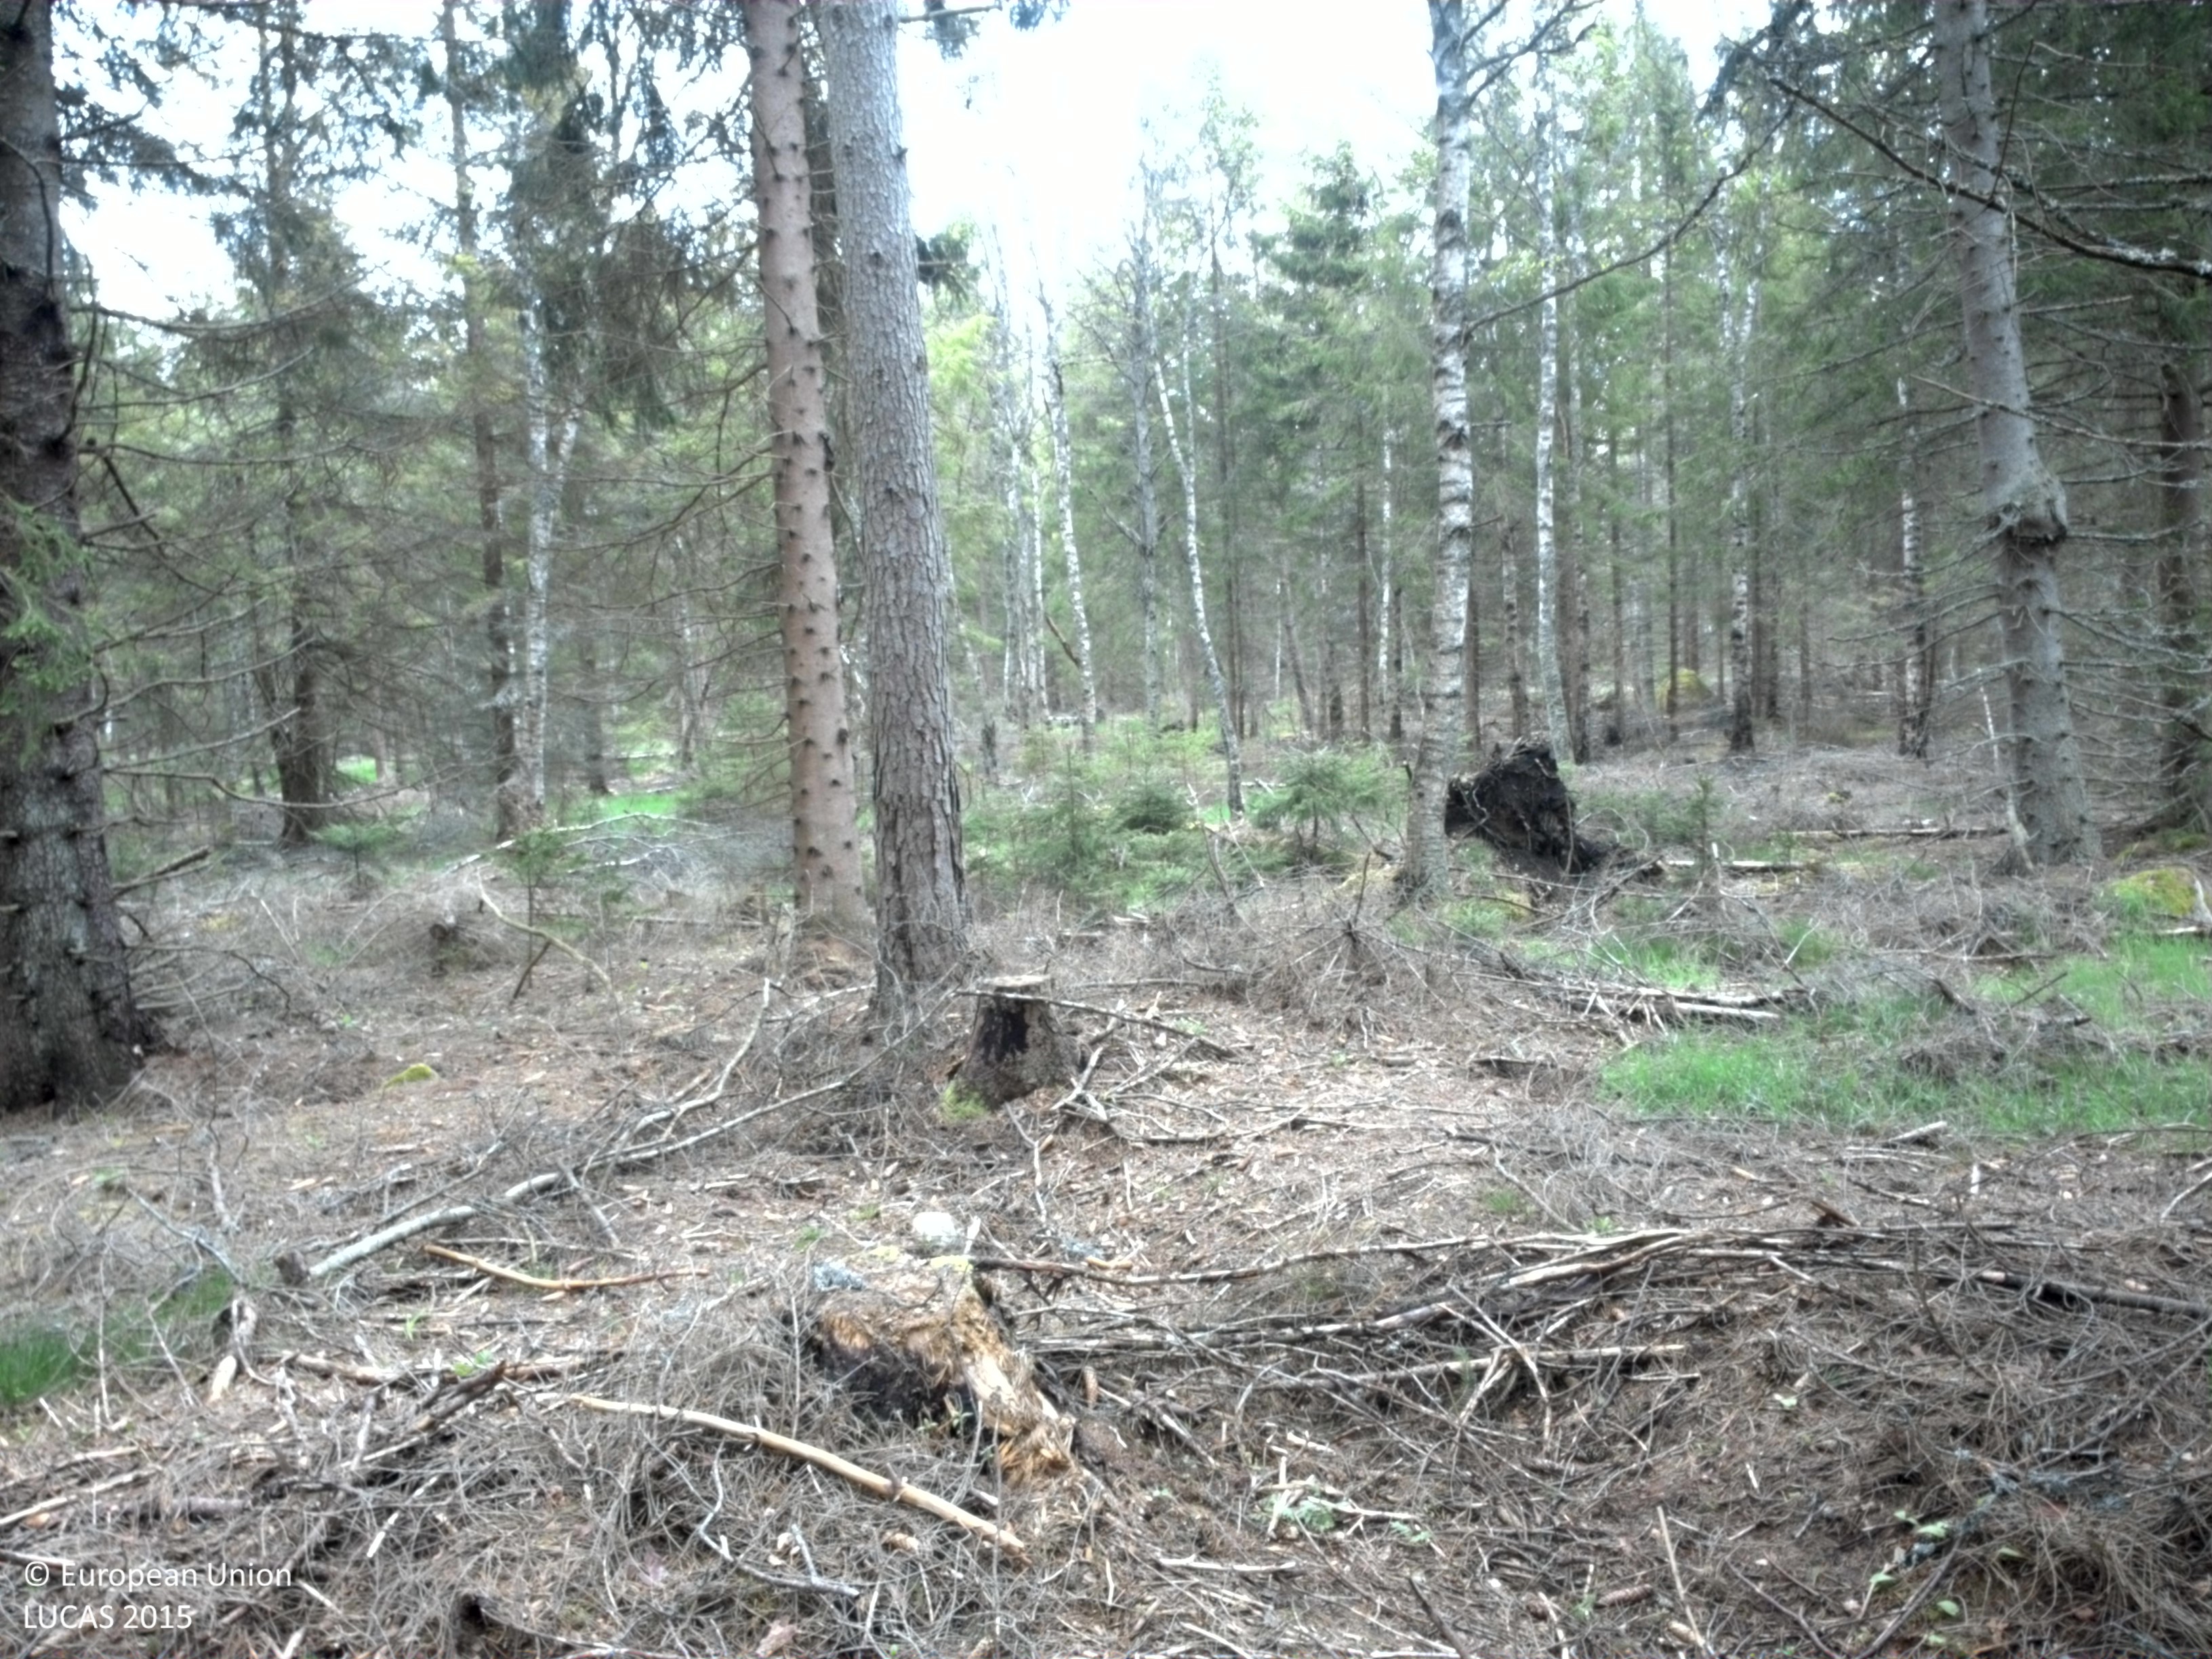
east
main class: Woodland
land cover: Spruce dominated coniferous woodland
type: boreal forest
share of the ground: 50 - 75 %
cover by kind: coniferous forest trees 50 %, herbaceous plants 15 %, broadleaved forest trees 10 %, lichens and mosses 10 %, unconsolidated bare surface 10 %, shrubs 5 %
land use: Forestry
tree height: > 5 m
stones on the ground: < 10 %
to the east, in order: Spruce dominated coniferous woodland; Ditches and canals; Spruce dominated mixed woodland; Spruce dominated coniferous woodland; Grassland with sparse tree/shrub cover; Spruce dominated coniferous woodland; Grassland with sparse tree/shrub cover; Spruce dominated coniferous woodland
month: May
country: SE
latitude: 56.8075
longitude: 15.0913
